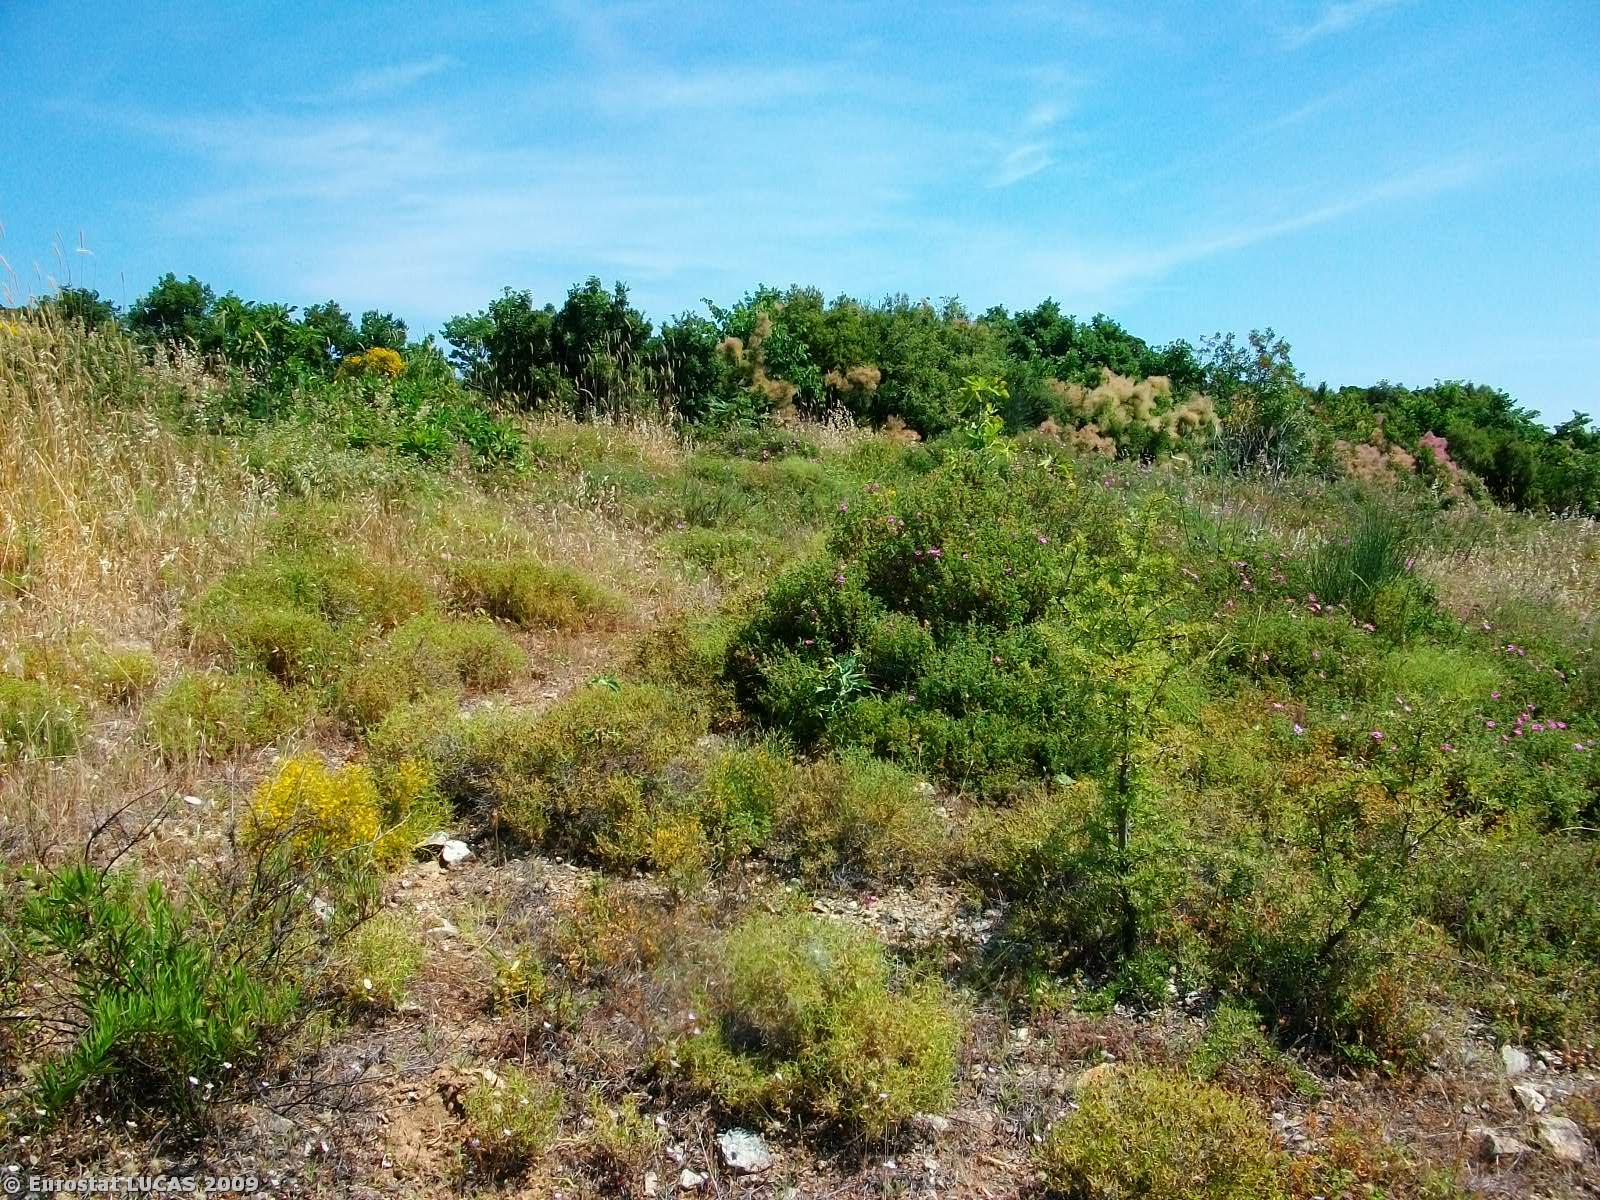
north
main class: Shrubland
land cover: Shrubland without tree cover
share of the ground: > 75 %
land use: Unused
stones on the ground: > 50 %
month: June
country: GR
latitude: 39.2203
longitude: 23.2316
